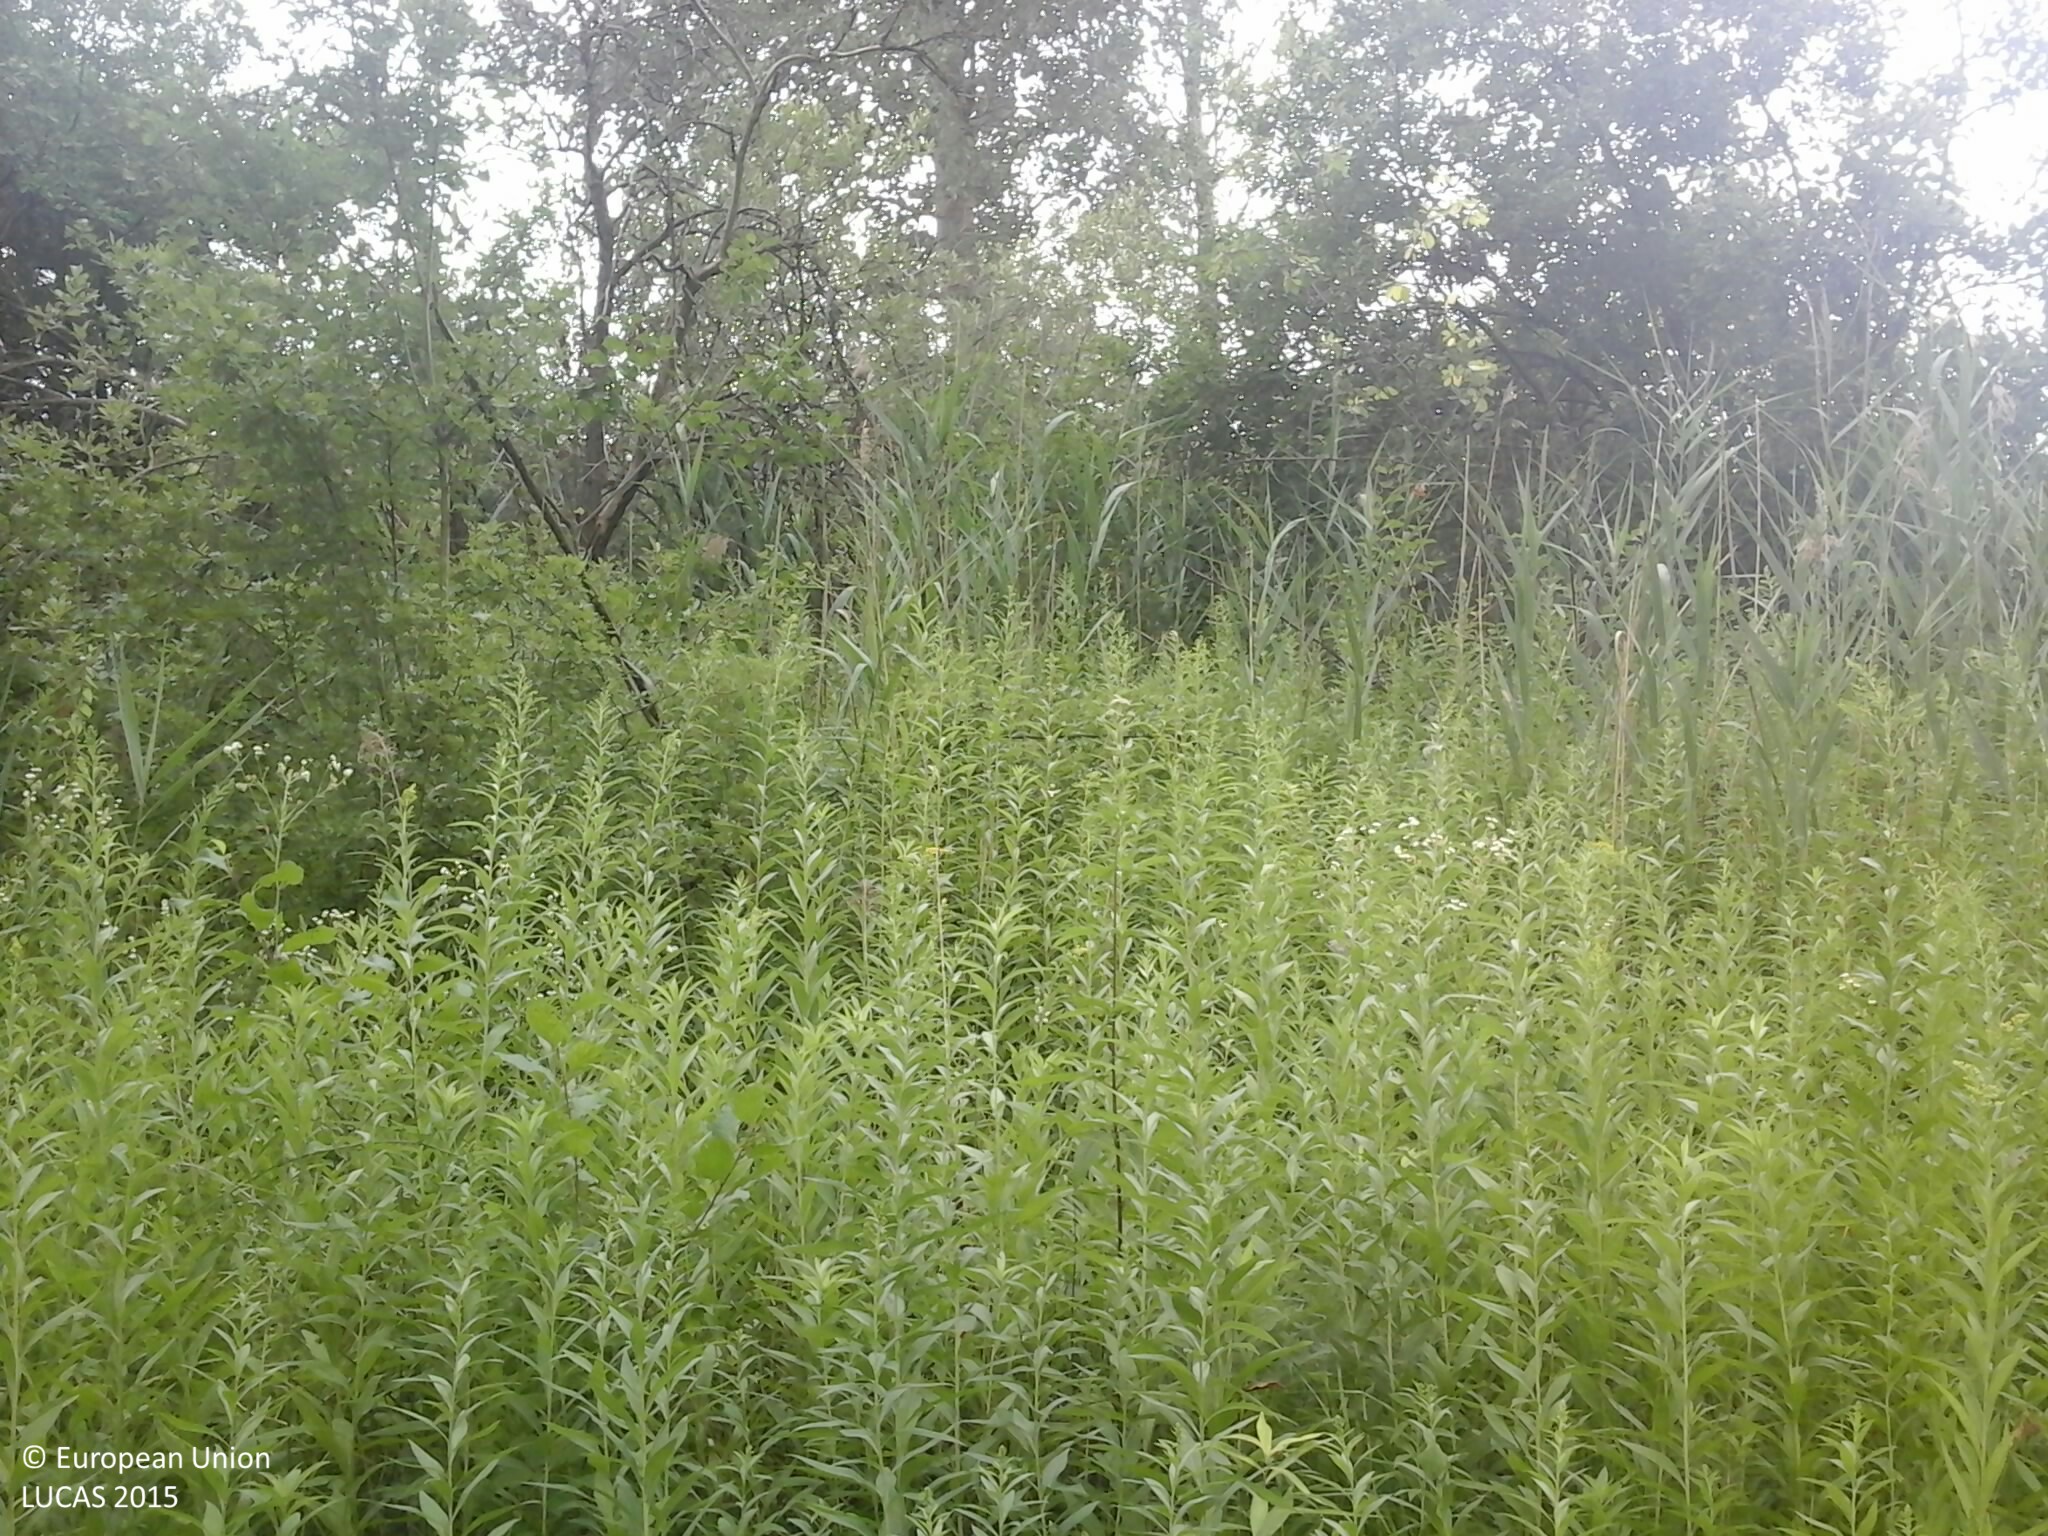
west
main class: Woodland
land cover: Broadleaved woodland
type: non-riverine alder, birch or aspen forest
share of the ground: > 75 %
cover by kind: broadleaved forest trees 80 %, shrubs 10 %, herbaceous plants 10 %
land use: Forestry
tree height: > 5 m
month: July
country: HU
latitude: 47.7428
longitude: 22.2034
